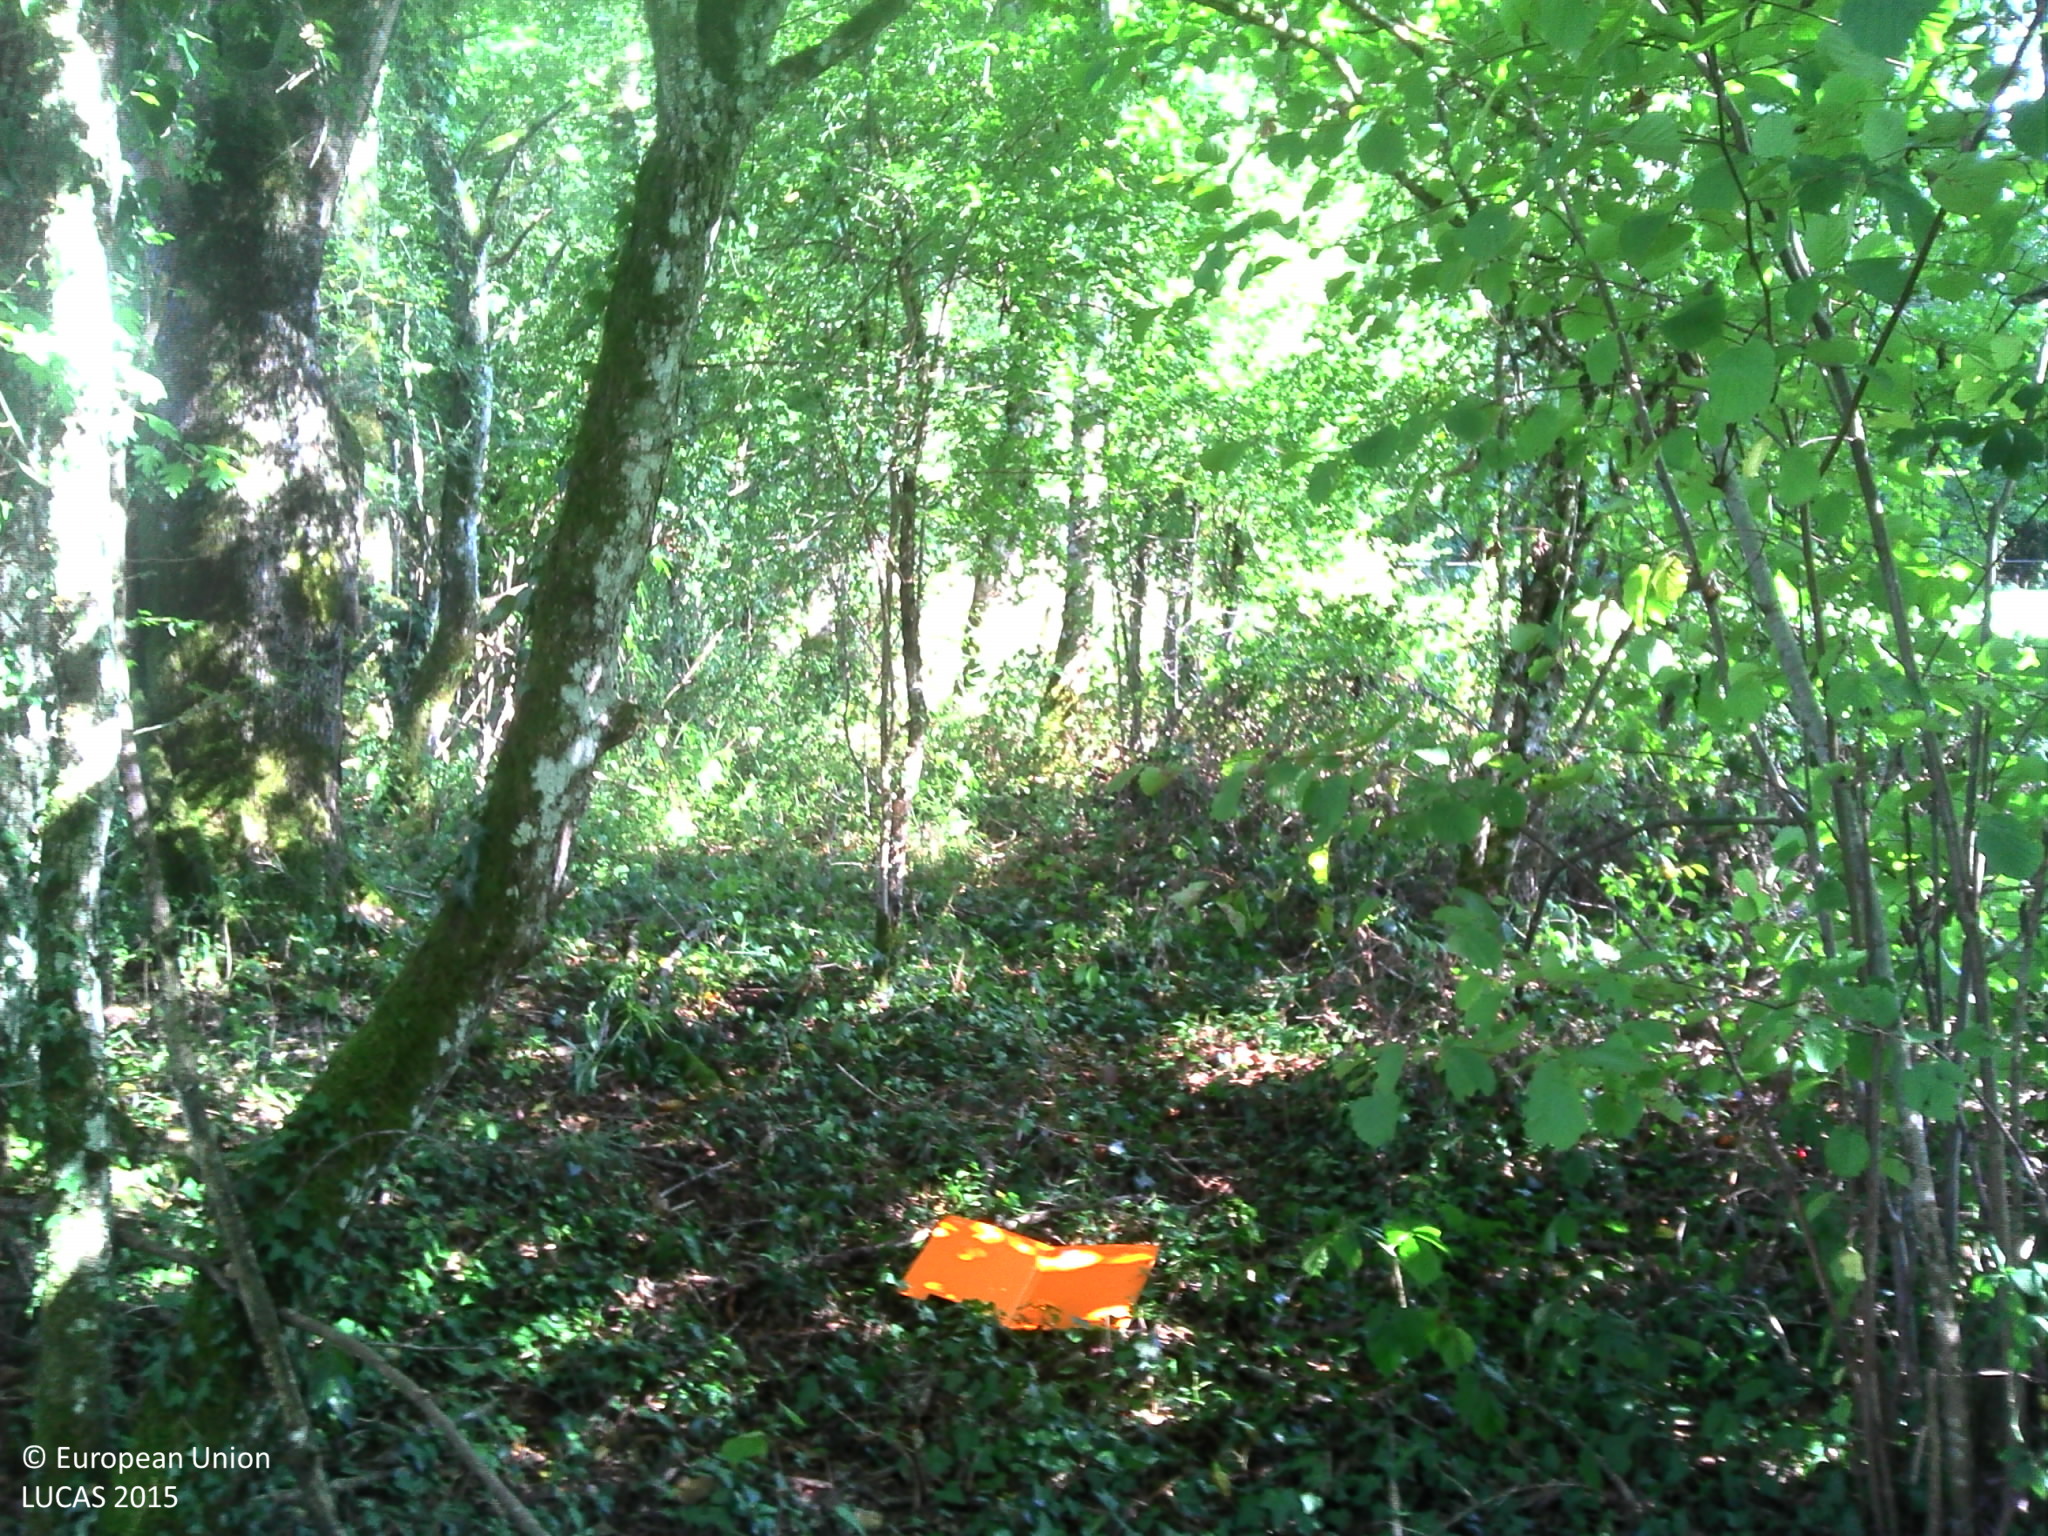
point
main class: Woodland
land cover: Broadleaved woodland
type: mesophytic deciduous forest
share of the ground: > 75 %
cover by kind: broadleaved forest trees 85 %, herbaceous plants 10 %
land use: Forestry
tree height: > 5 m
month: September
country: FR
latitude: 47.5231
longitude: 6.6150
